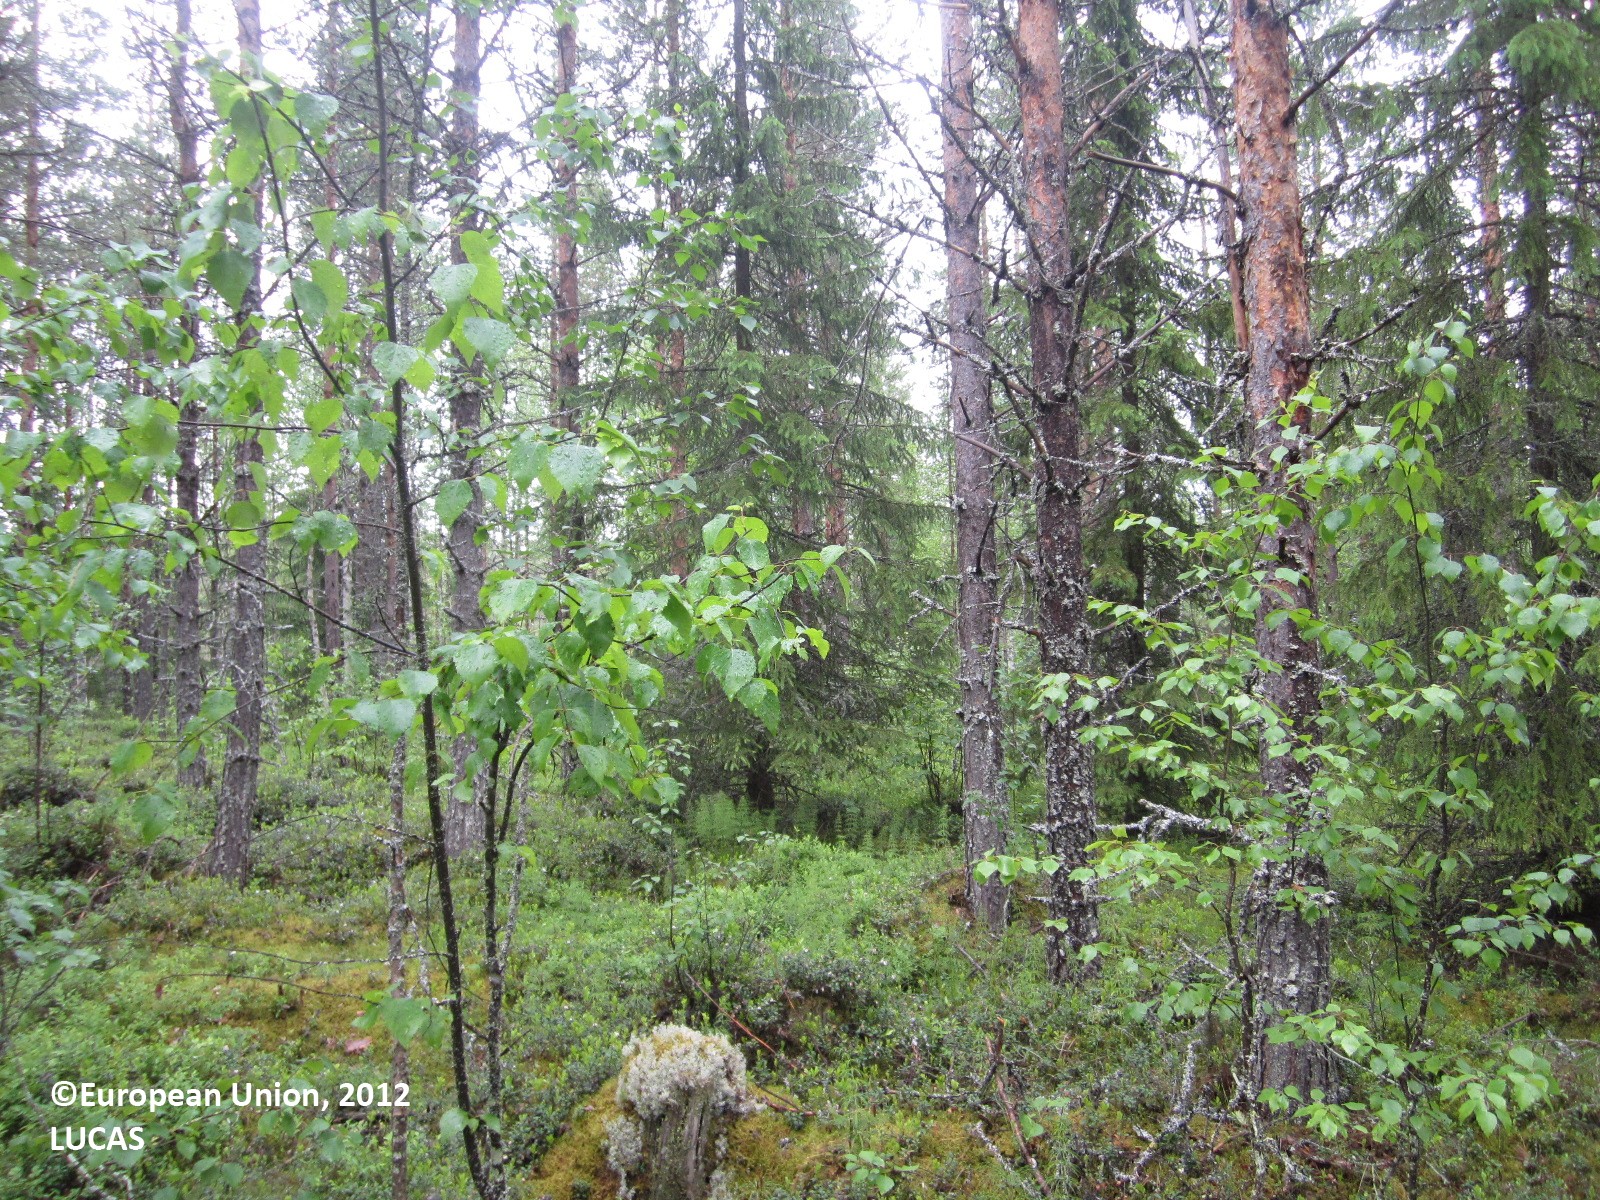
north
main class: Woodland
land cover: Other mixed woodland
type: boreal forest
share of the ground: > 75 %
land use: Forestry
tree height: > 5 m
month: June
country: FI
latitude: 64.5887
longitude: 29.2289
